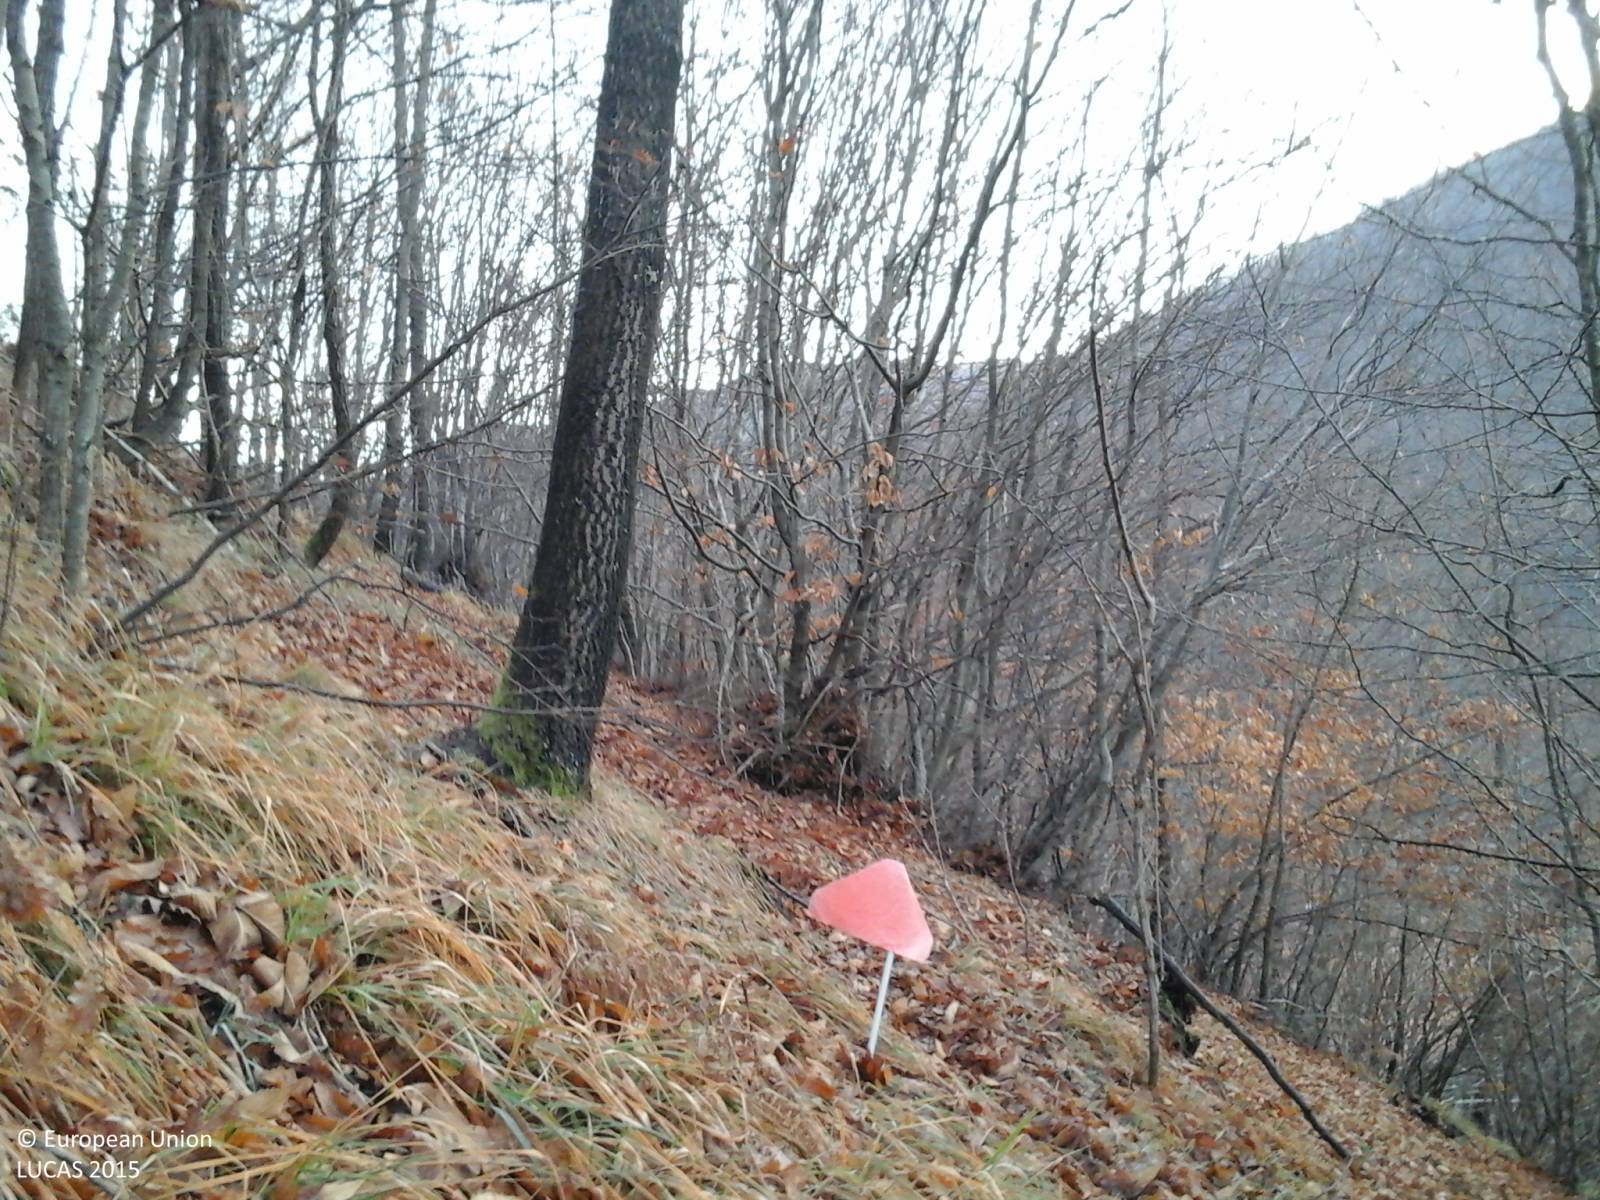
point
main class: Woodland
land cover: Broadleaved woodland
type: thermophilous deciduous forest
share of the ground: > 75 %
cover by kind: broadleaved forest trees 100 %
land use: Forestry
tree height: > 5 m
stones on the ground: 10 - 25 %
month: January
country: IT
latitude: 44.0401
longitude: 10.8838
